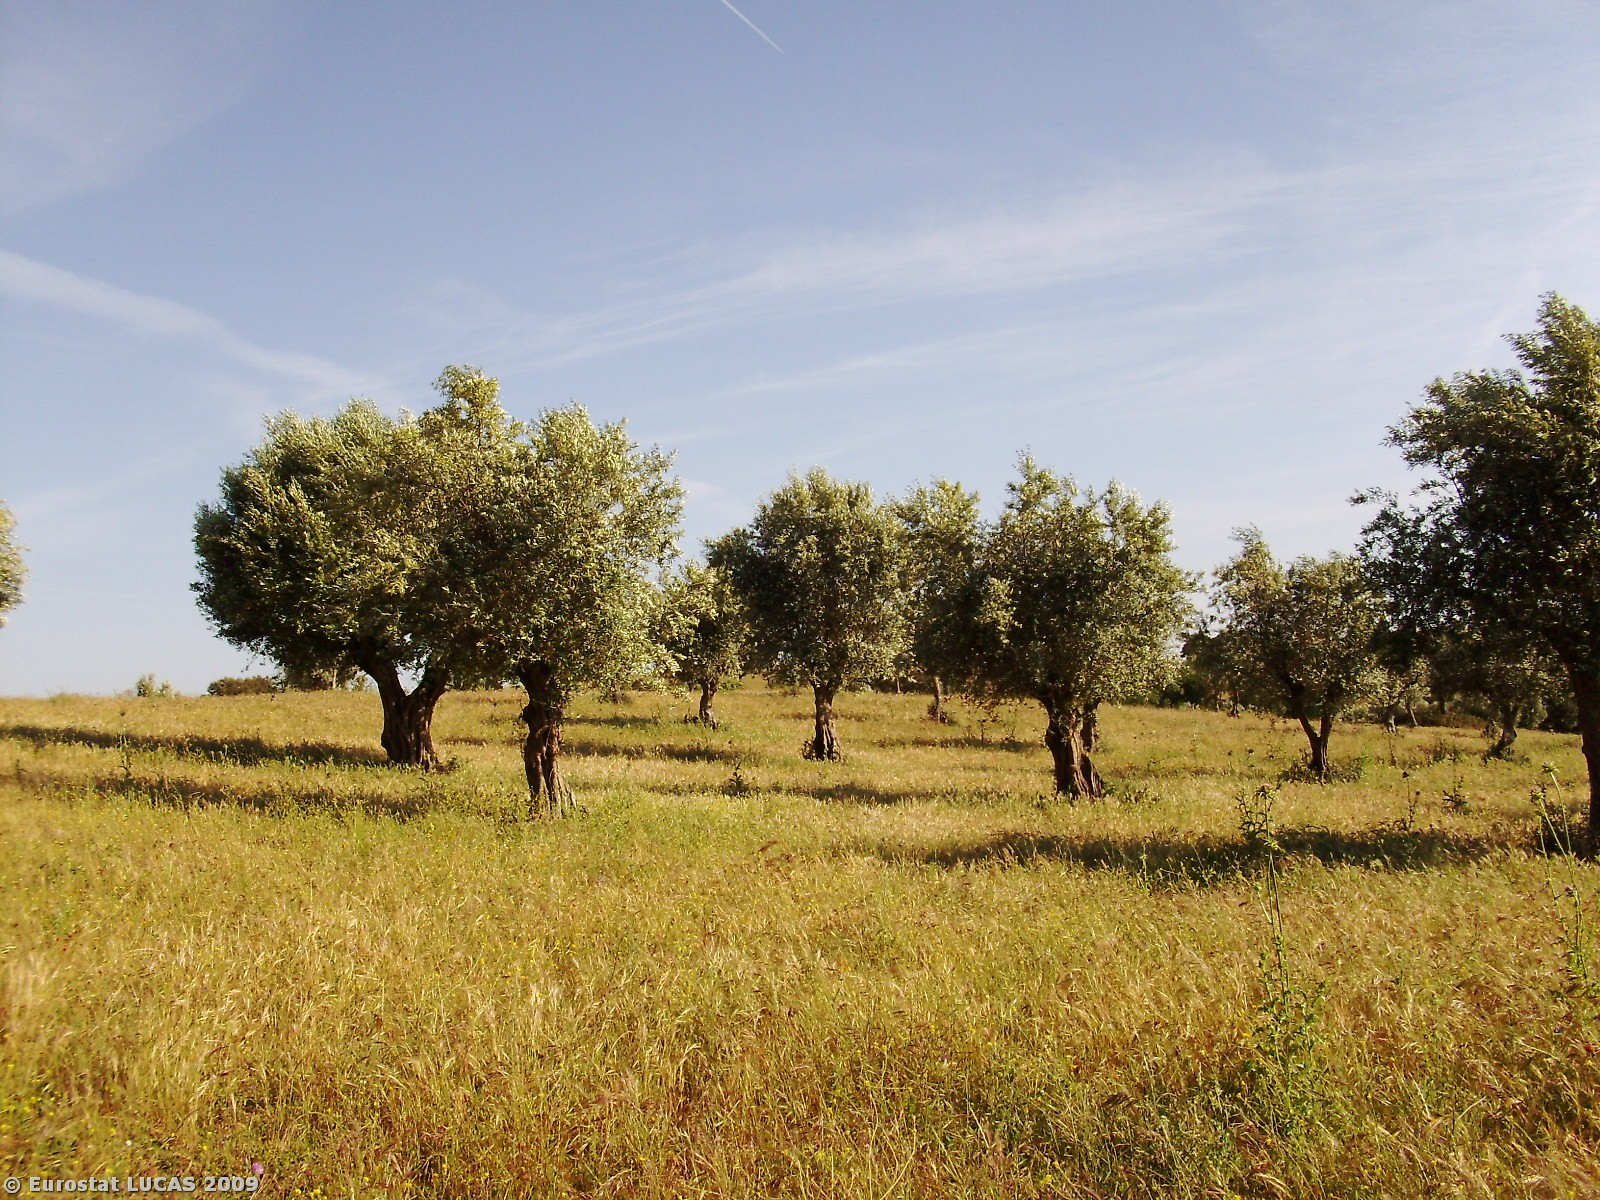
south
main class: Cropland
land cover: Olive groves
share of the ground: 10 - 25 %
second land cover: Grassland with sparse tree/shrub cover
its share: > 75 %
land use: Agriculture (excluding fallow land and kitchen gardens)
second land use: Fallow land
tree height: > 5 m
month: May
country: PT
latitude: 39.0705
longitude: -7.7877
